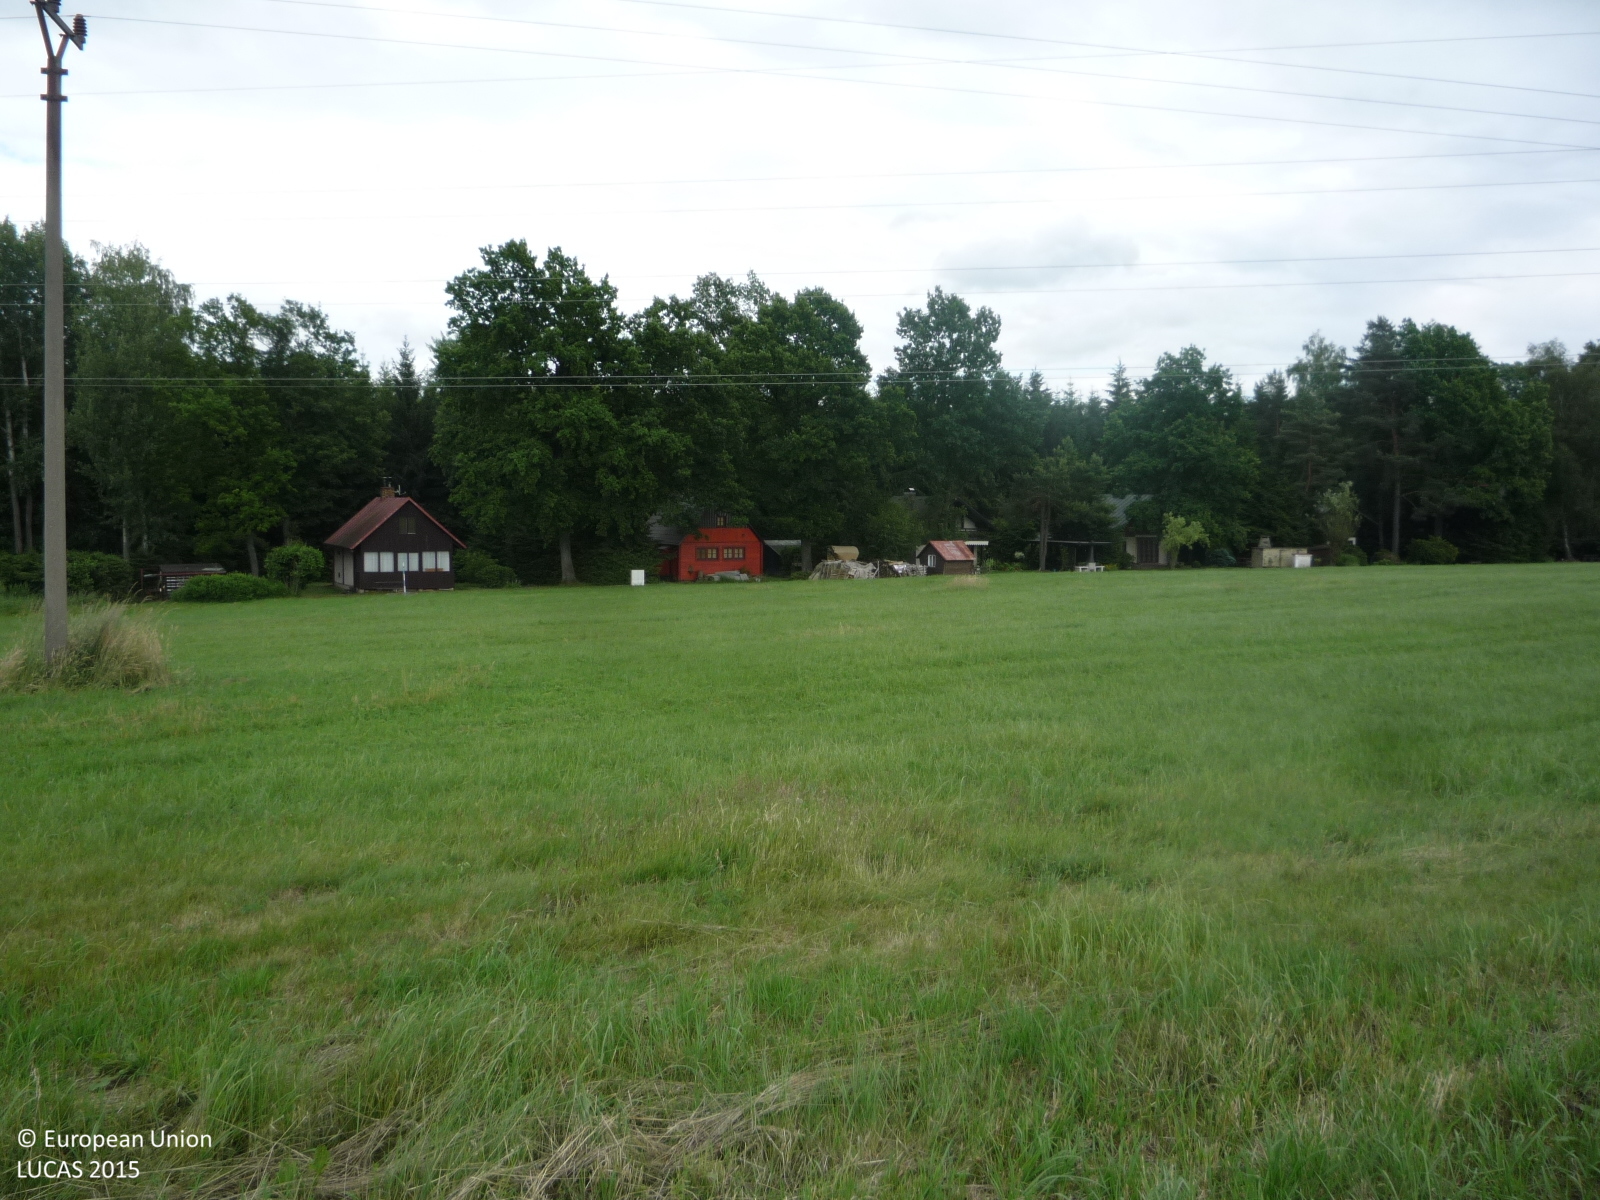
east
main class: Grassland
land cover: Grassland without tree/shrub cover
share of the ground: > 75 %
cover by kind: herbaceous plants 100 %
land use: Agriculture (excluding fallow land and kitchen gardens)
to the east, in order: Grassland without tree/shrub cover; Electric lines; Grassland without tree/shrub cover; Electric lines; Grassland without tree/shrub cover; Artificial constructions in urban areas; Spruce dominated coniferous woodland; Tracks; Spruce dominated coniferous woodland; Artificial constructions in urban areas; Spruce dominated coniferous woodland; Tracks; Broadleaved woodland
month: June
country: CZ
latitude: 49.8286
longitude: 15.6345
